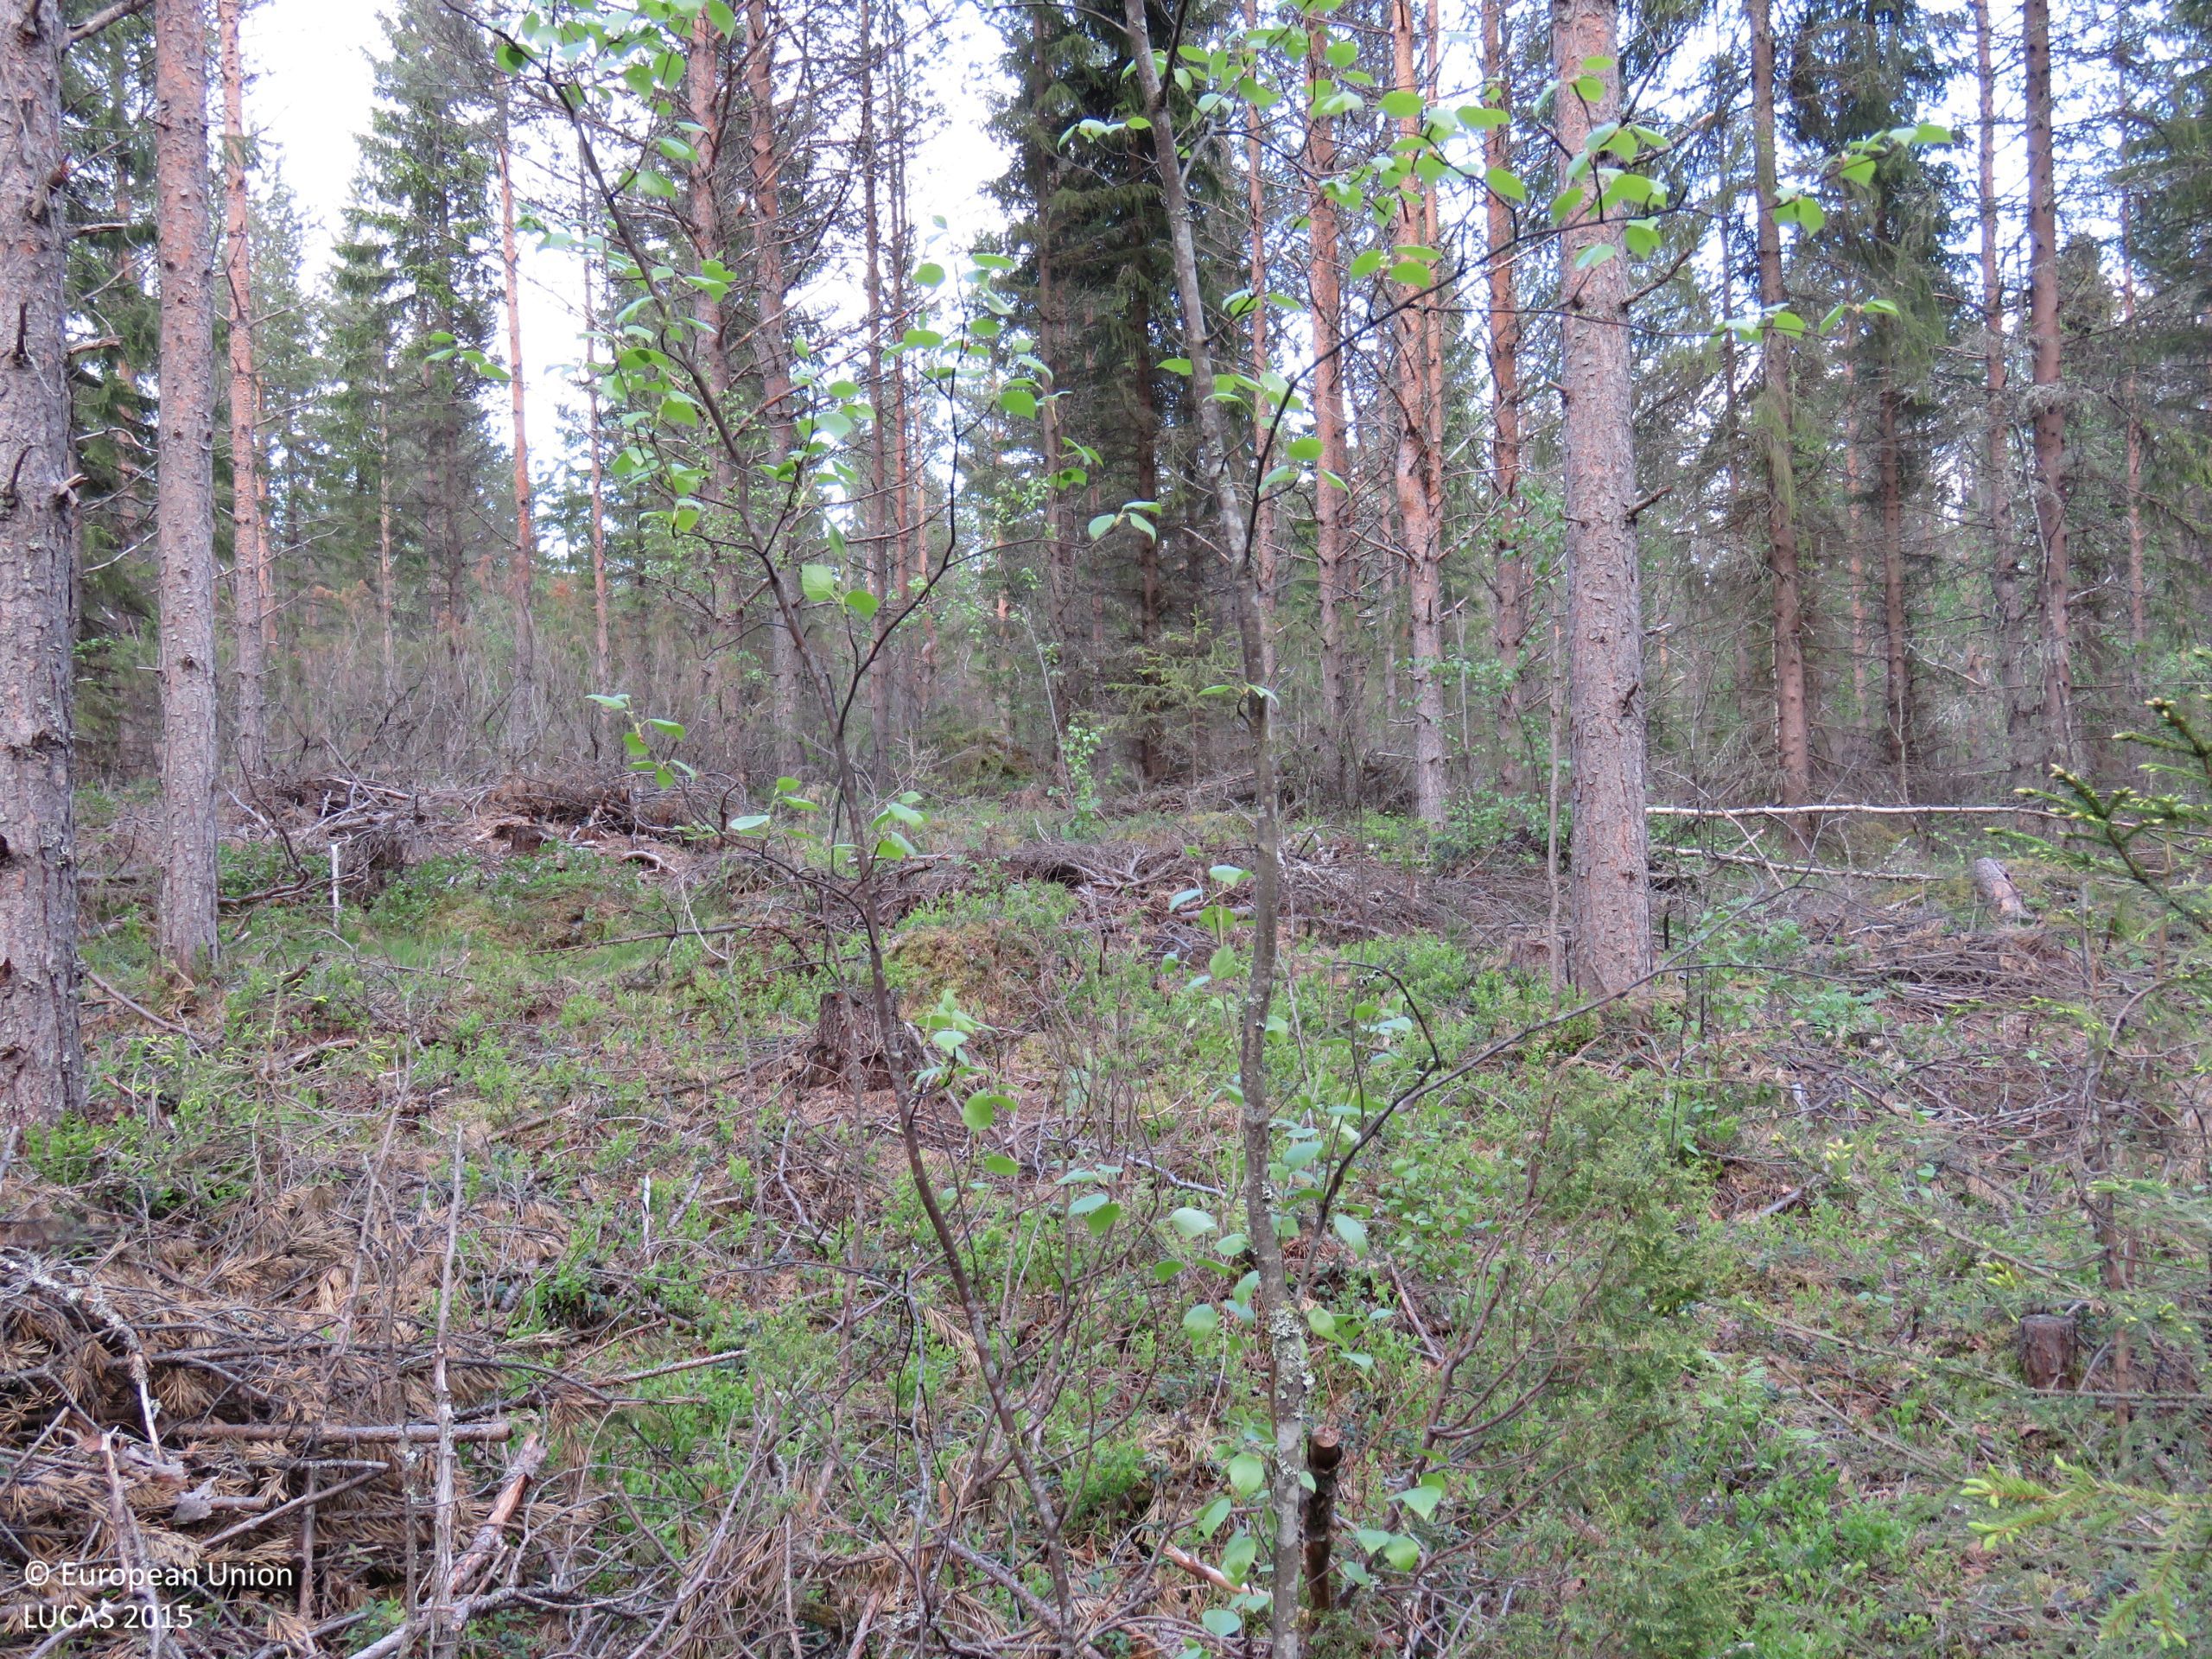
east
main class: Woodland
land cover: Other coniferous woodland
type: boreal forest
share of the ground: 50 - 75 %
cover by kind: coniferous forest trees 60 %, shrubs 30 %, broadleaved forest trees 5 %, lichens and mosses 5 %
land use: Forestry
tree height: > 5 m
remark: Clear cut
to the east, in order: Other coniferous woodland; Tracks; Spruce dominated coniferous woodland; Other mixed woodland
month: June
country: FI
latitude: 65.0524
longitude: 25.7053
